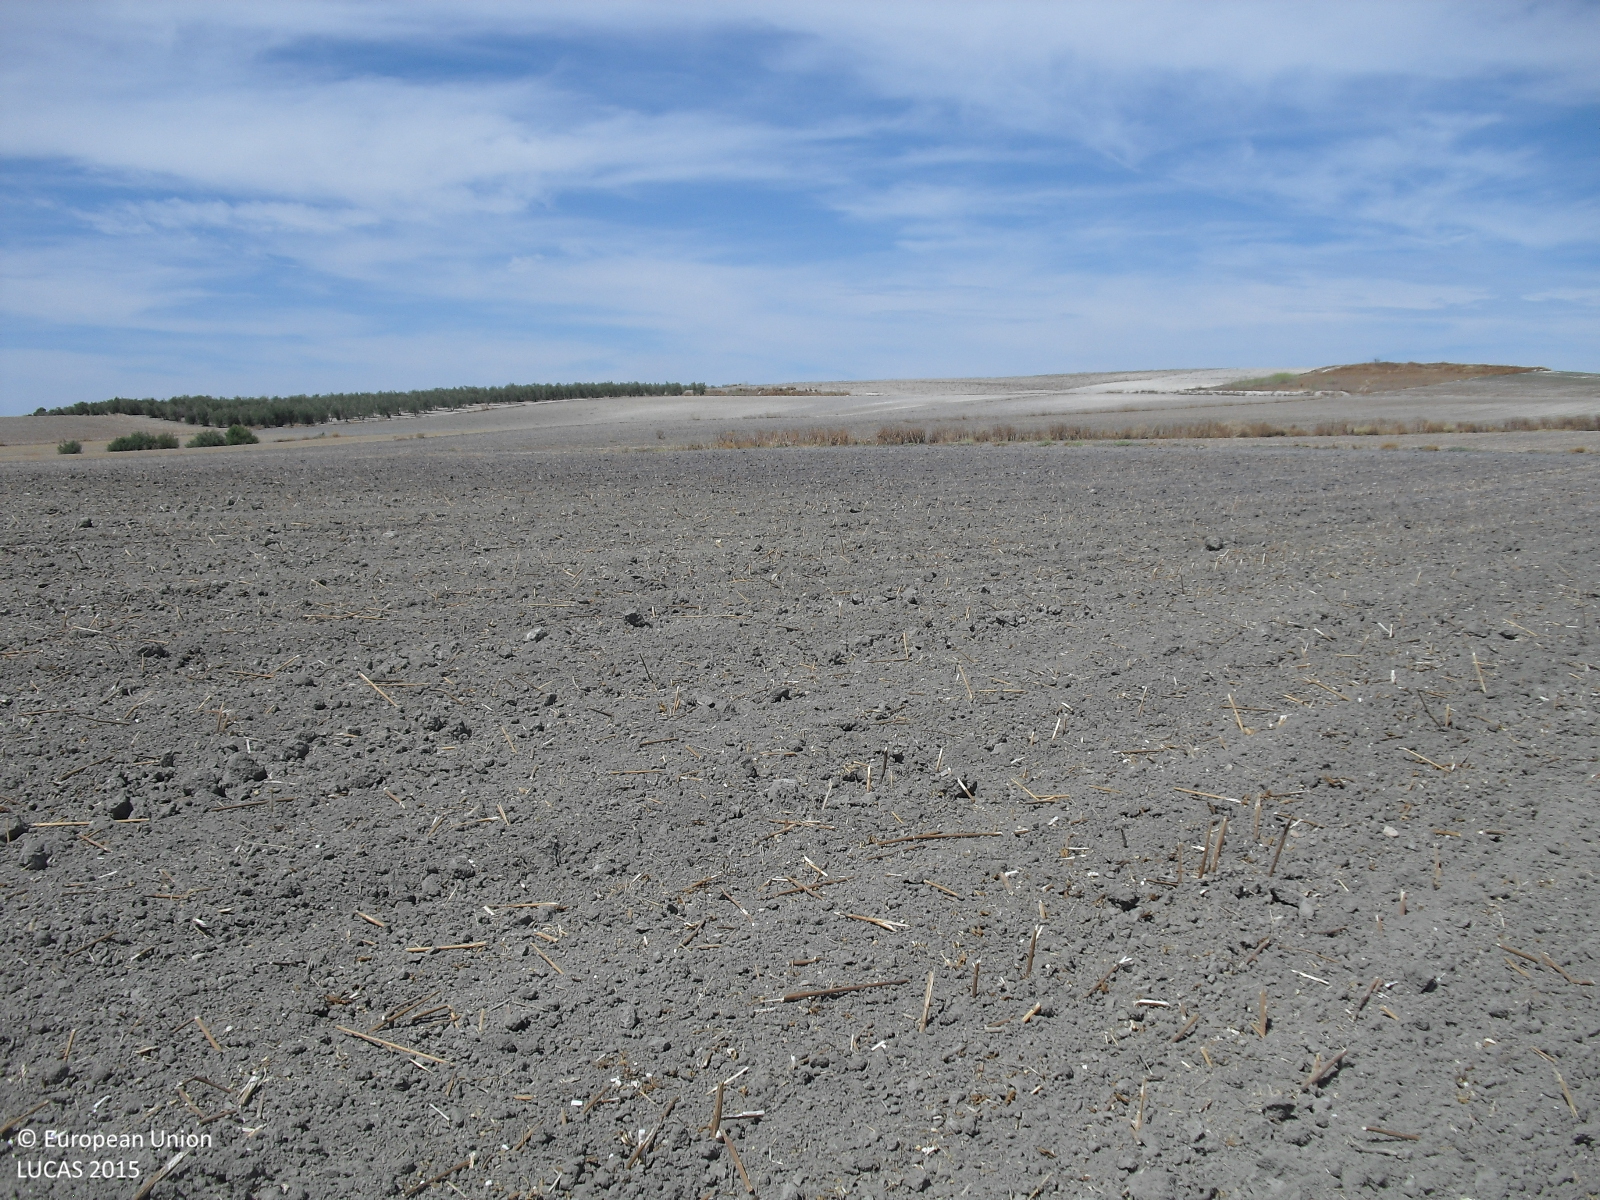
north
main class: Cropland
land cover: Sunflower
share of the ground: < 10 %
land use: Agriculture (excluding fallow land and kitchen gardens)
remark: Harvested field
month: August
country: ES
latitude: 37.3959
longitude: -5.5716
